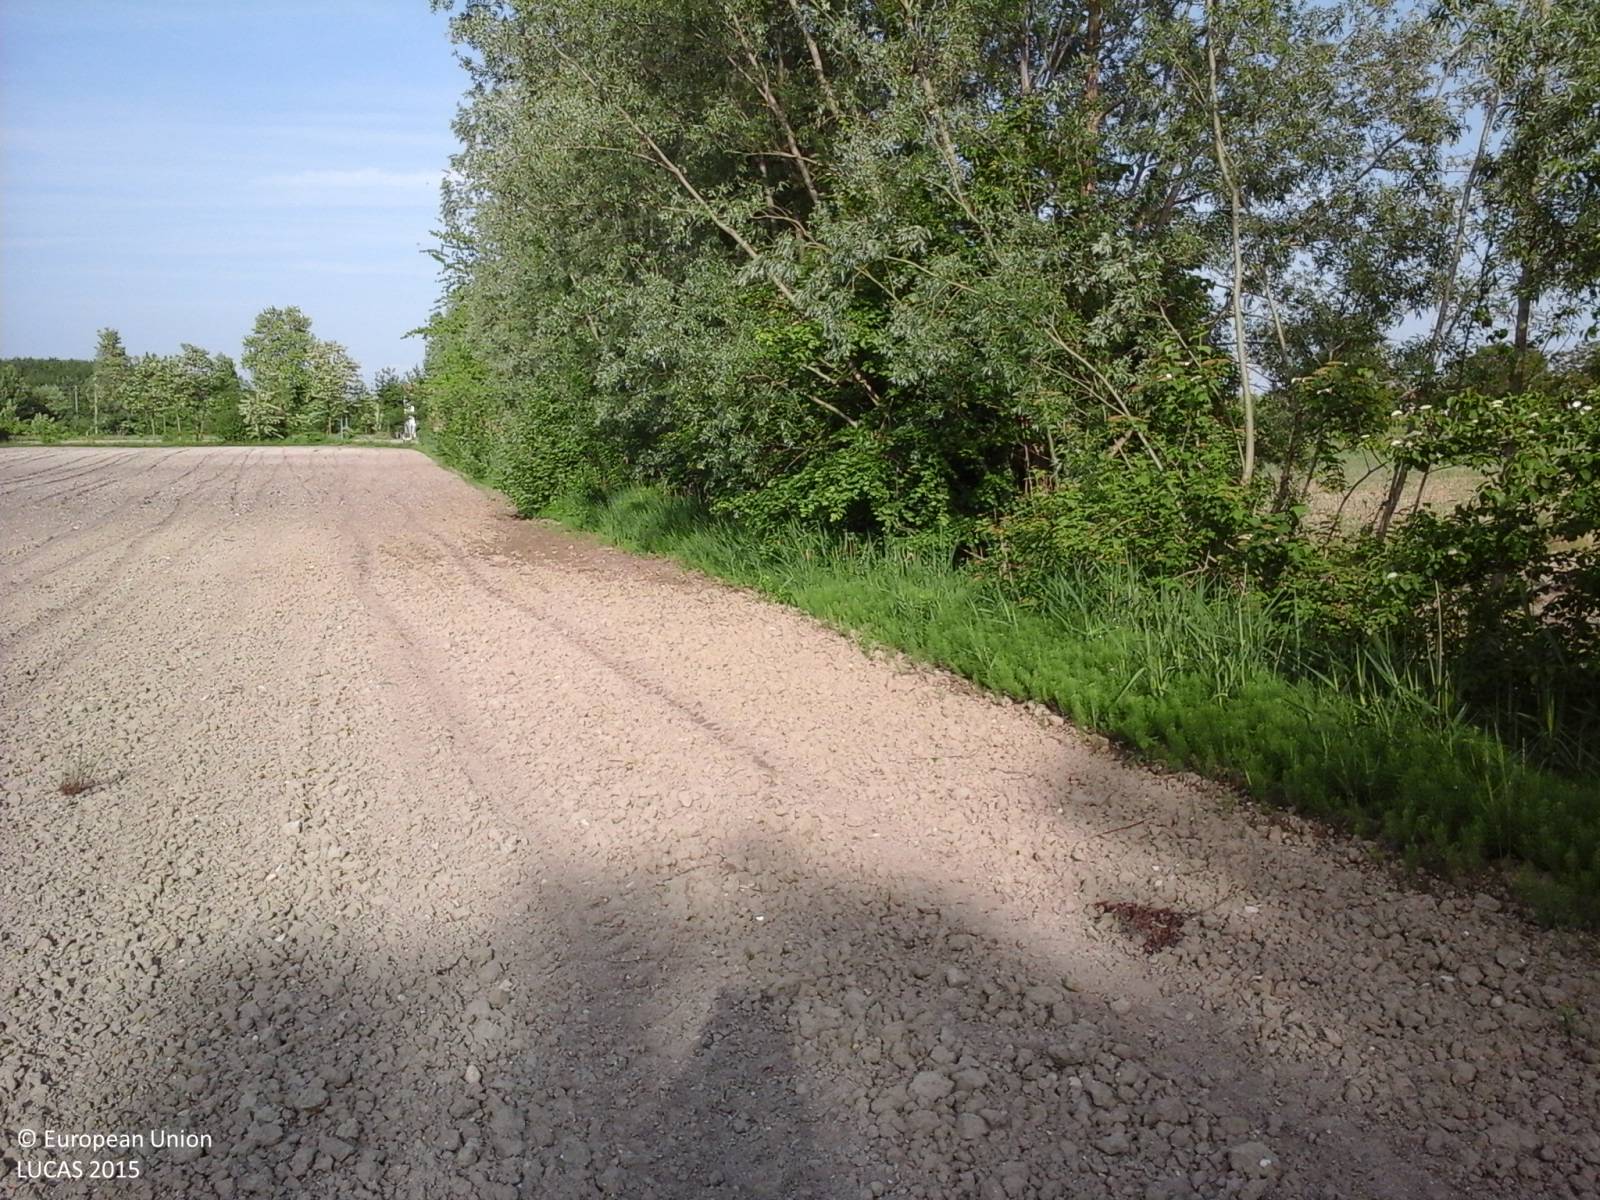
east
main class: Cropland
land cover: Soya
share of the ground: < 10 %
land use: Agriculture (excluding fallow land and kitchen gardens)
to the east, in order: Soya; Grass margins; Ditches and canals; Abandoned hedges; Grass margins; Grassland without tree/shrub cover; Abandoned hedges; Ditches and canals; Grassland without tree/shrub cover; Broadleaved woodland; Grass margins; Soya; Ditches and canals; Grass margins; Paved roads, cycling and walking lanes; Grass margins; Ditches and canals; Electric lines; Artificial constructions in urban areas
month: May
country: IT
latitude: 45.8751
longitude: 13.0496
